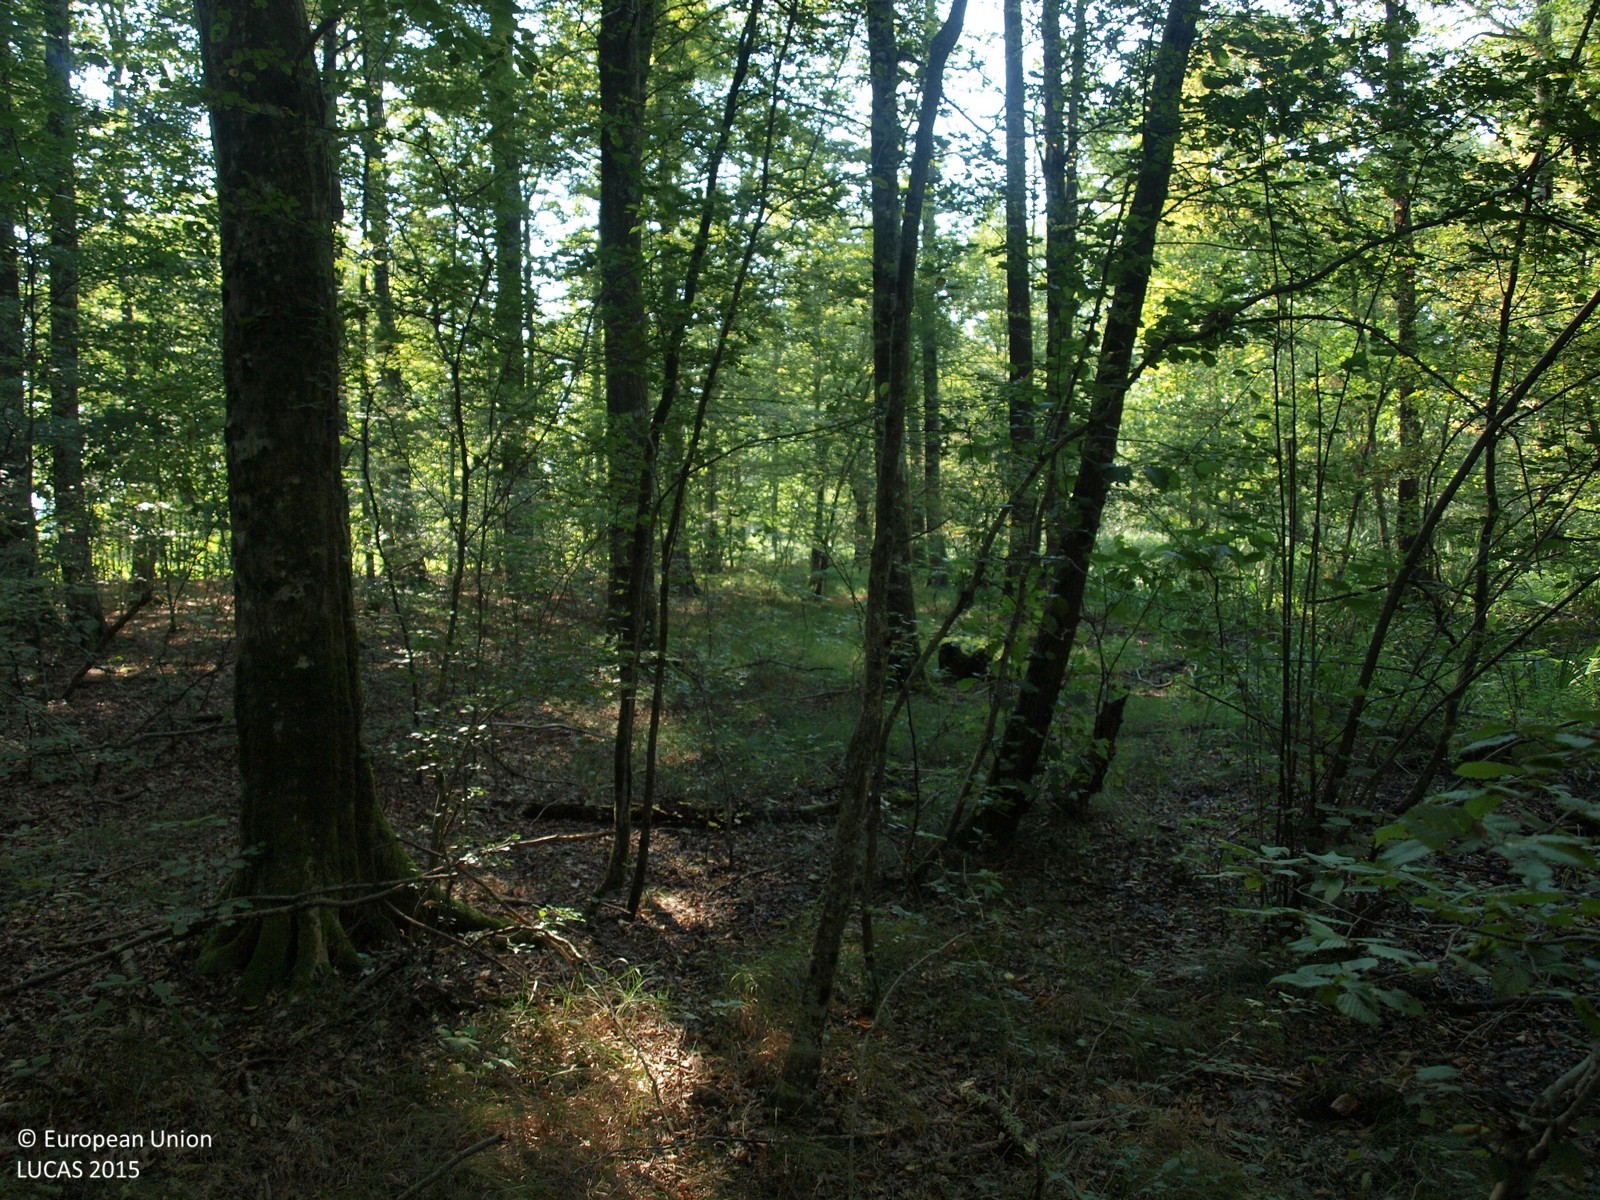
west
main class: Woodland
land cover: Broadleaved woodland
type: floodplain forest
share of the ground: > 75 %
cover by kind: broadleaved forest trees 100 %
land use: Forestry
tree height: > 5 m
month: August
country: HR
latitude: 45.6324
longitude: 16.4508
